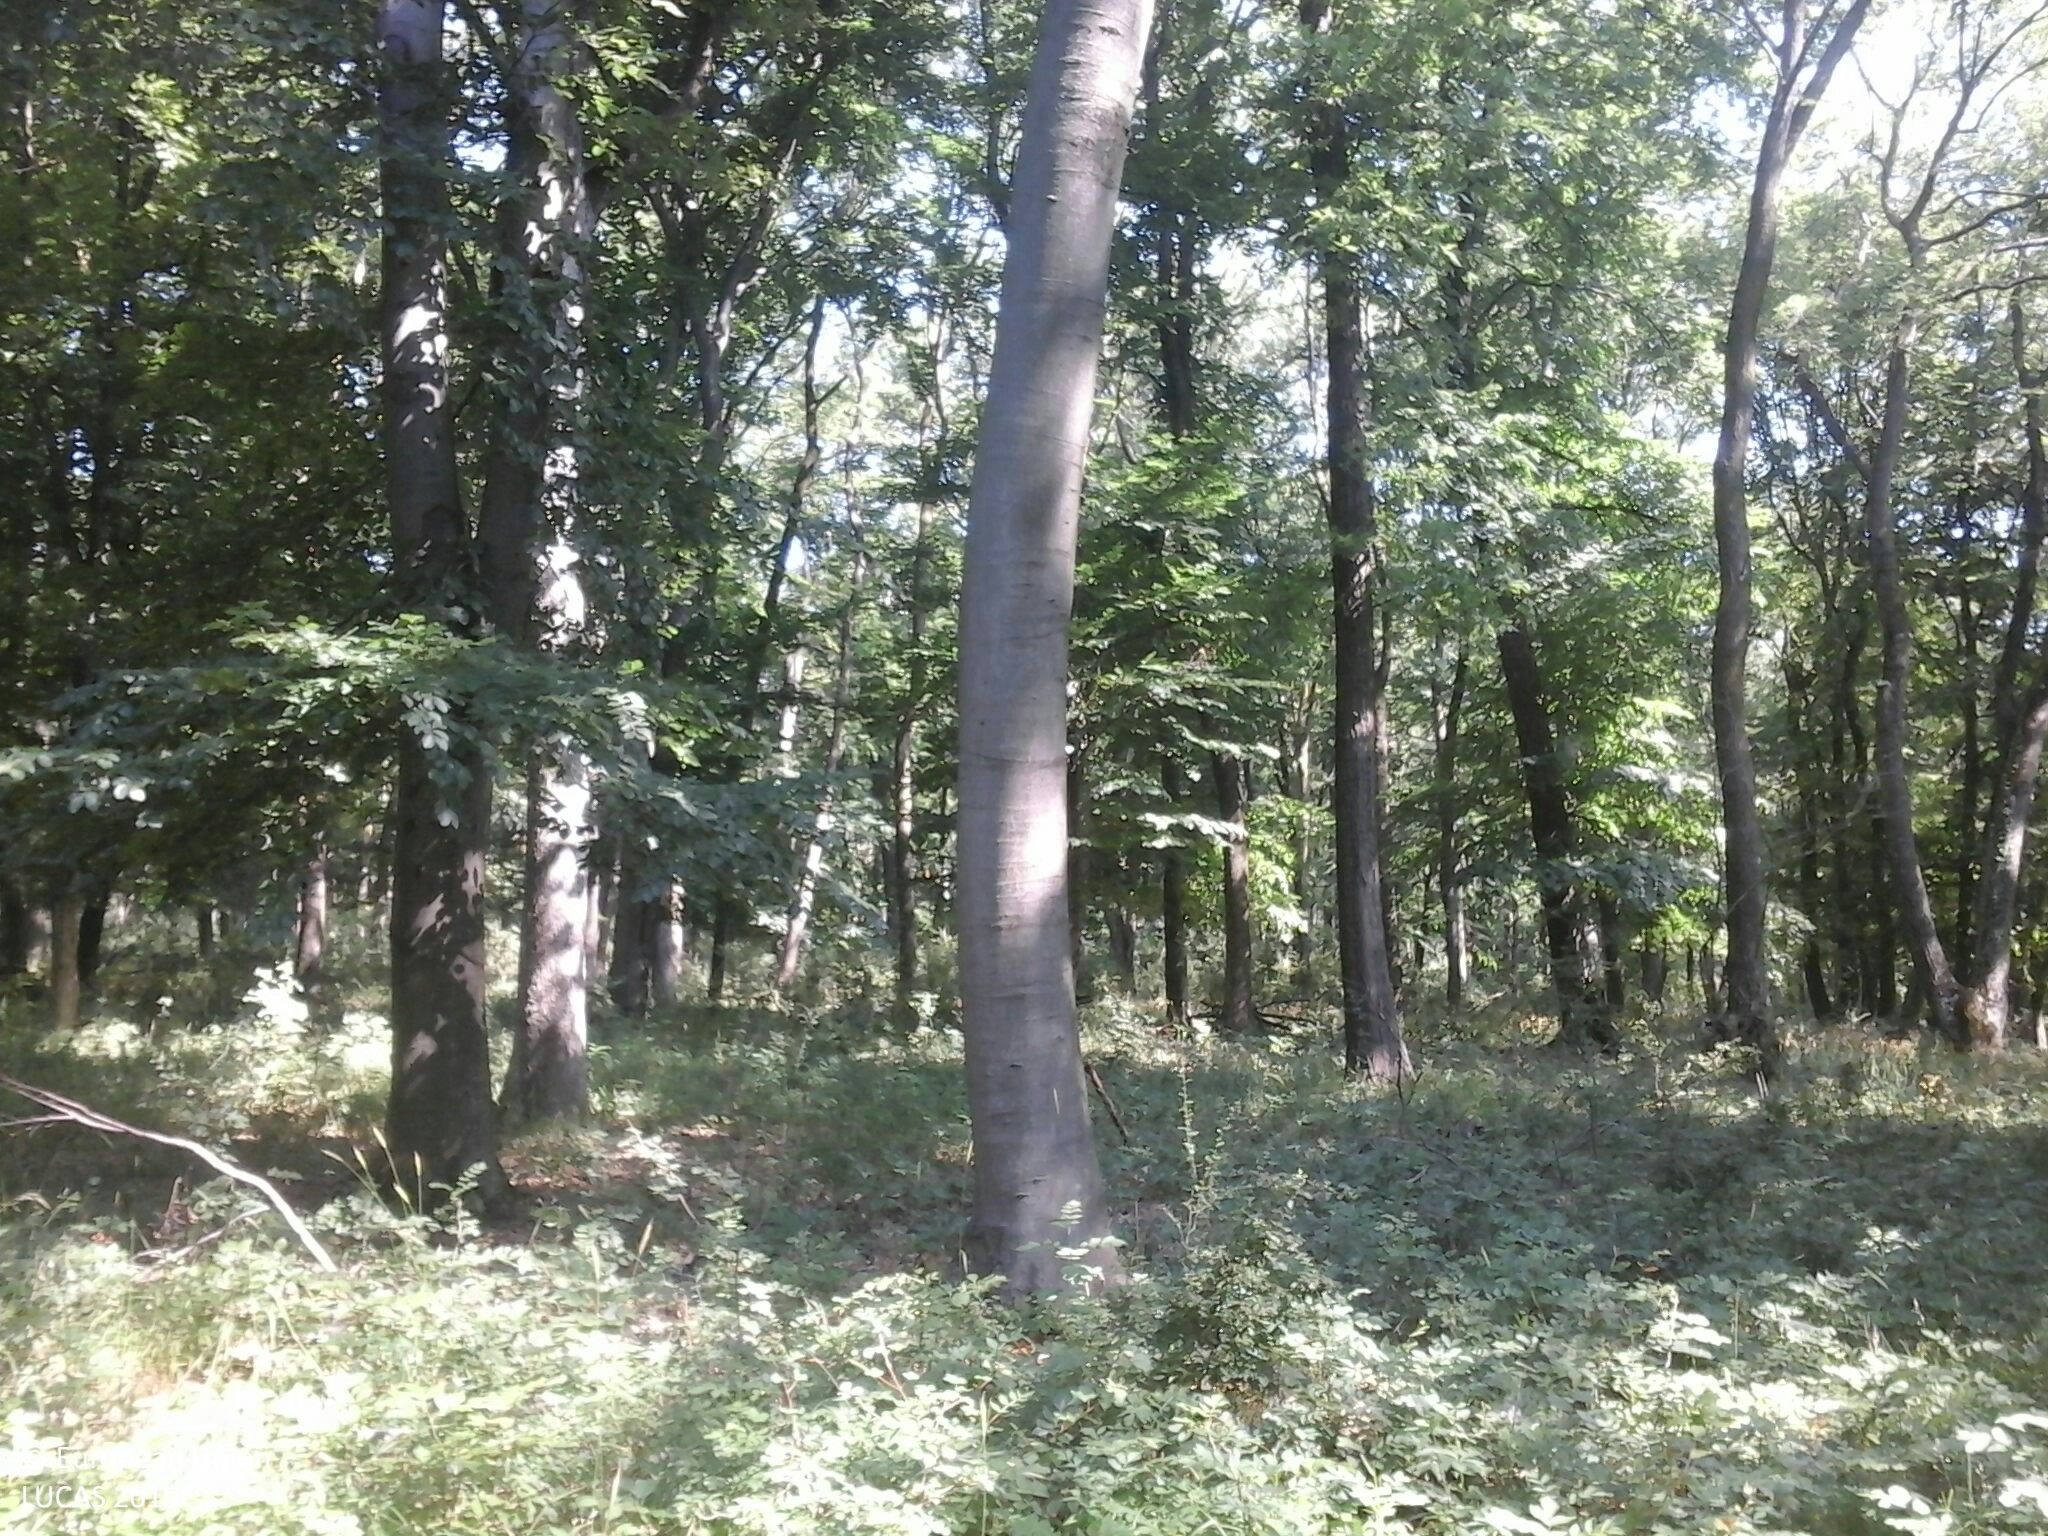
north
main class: Woodland
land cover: Broadleaved woodland
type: beech forest
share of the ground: > 75 %
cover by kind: broadleaved forest trees 95 %, herbaceous plants 5 %
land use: Forestry
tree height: > 5 m
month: July
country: HU
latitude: 47.1672
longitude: 17.8318
